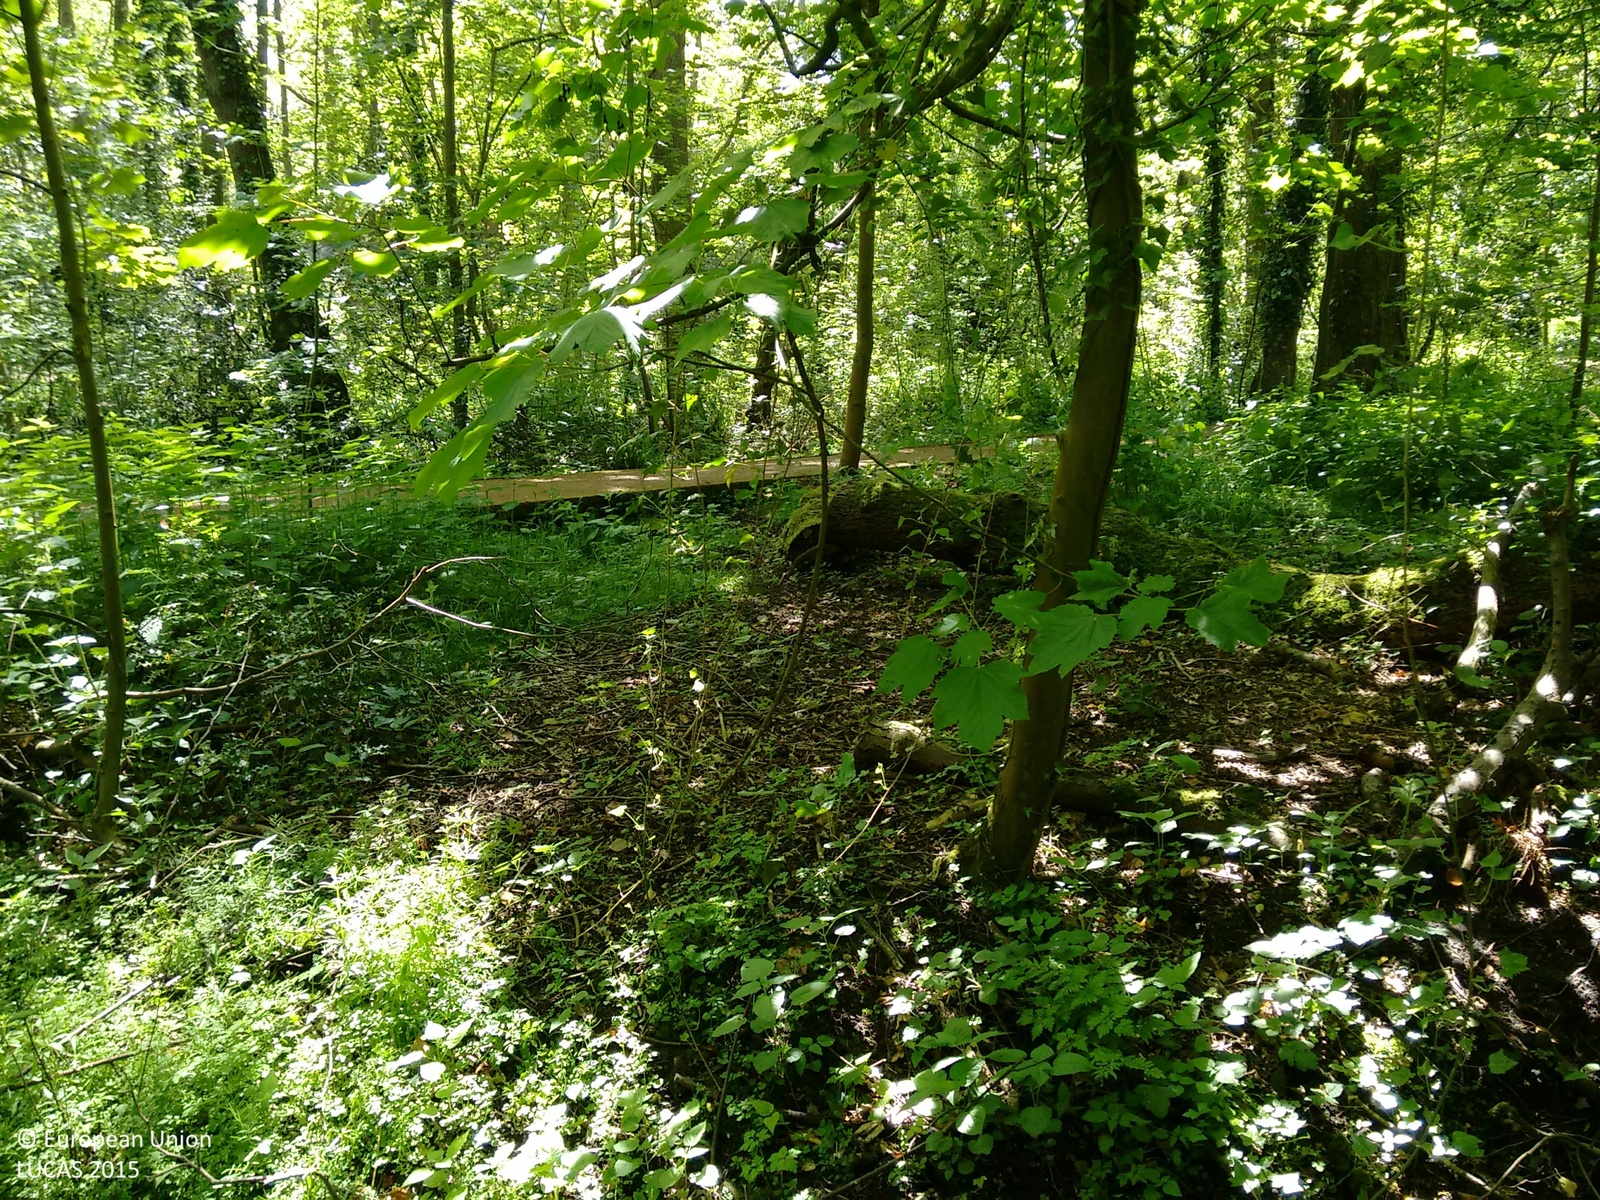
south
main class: Woodland
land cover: Broadleaved woodland
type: mesophytic deciduous forest
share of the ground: > 75 %
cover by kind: broadleaved forest trees 80 %, shrubs 10 %, herbaceous plants 10 %
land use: Amenities, museums, leisure
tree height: > 5 m
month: May
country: GB
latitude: 52.0891
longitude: -0.3257
